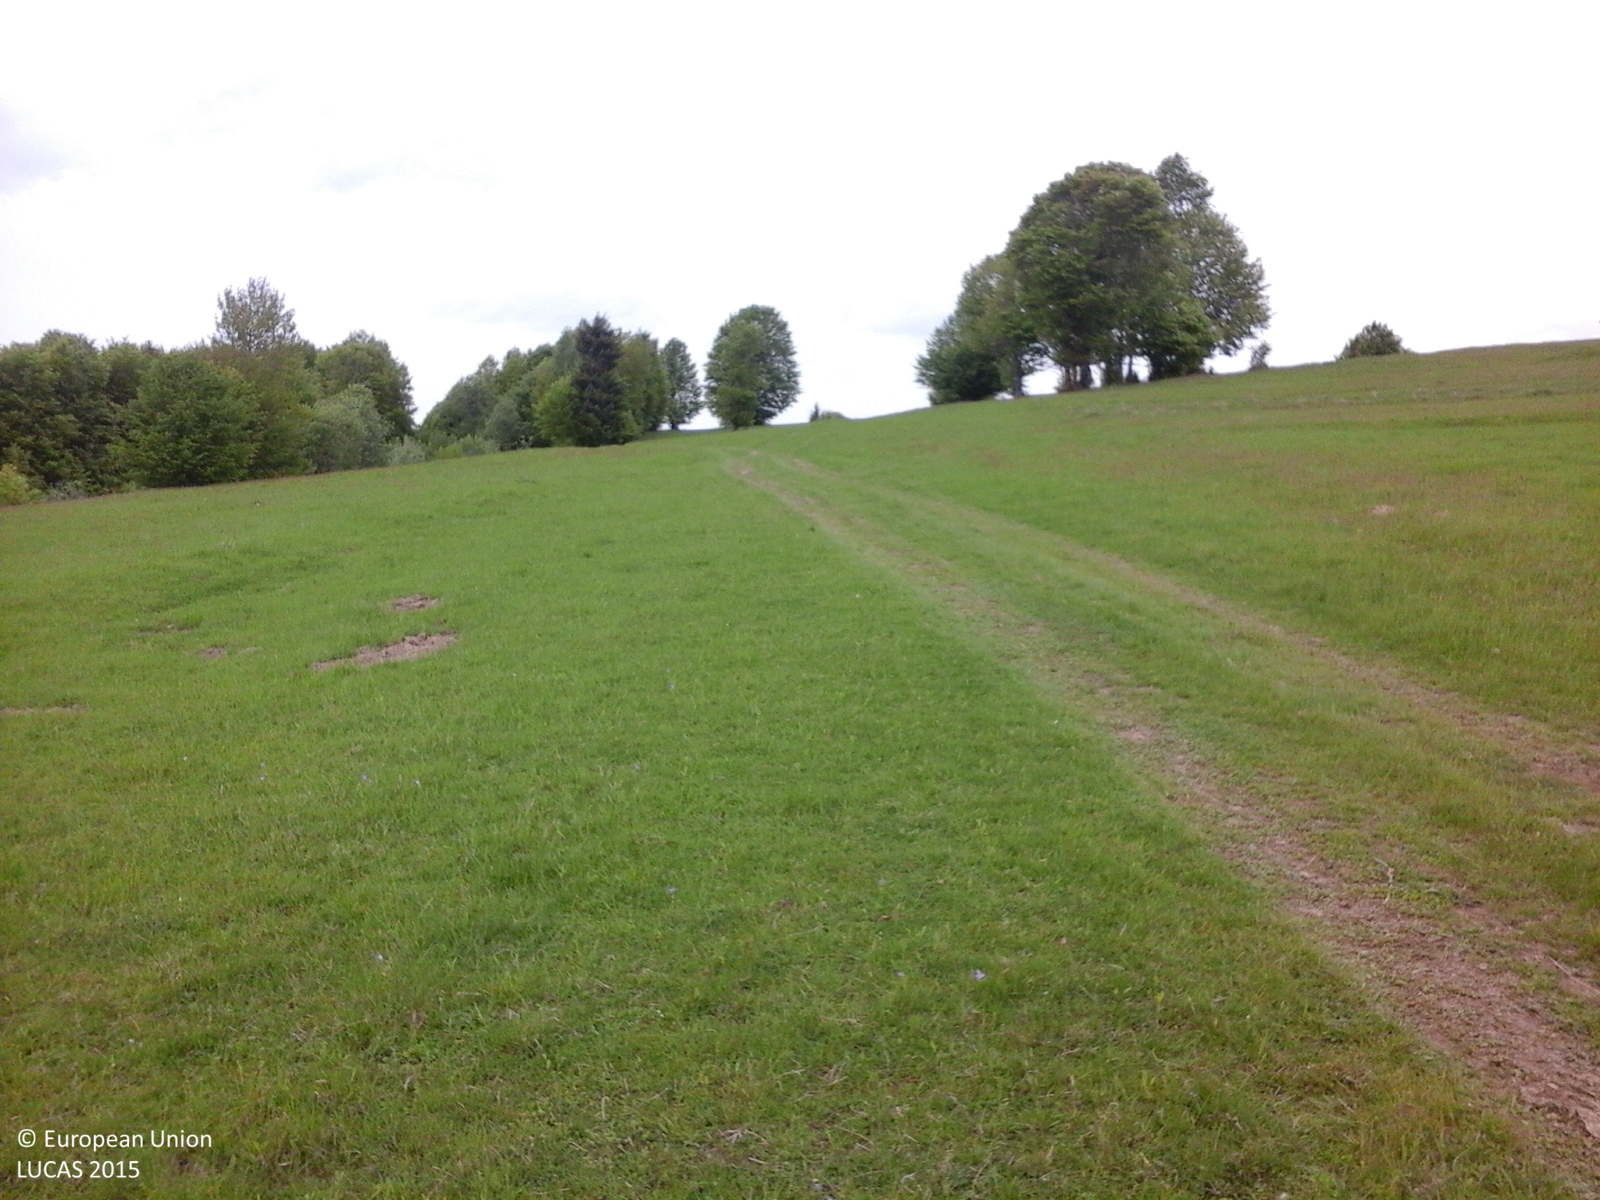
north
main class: Grassland
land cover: Grassland without tree/shrub cover
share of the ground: > 75 %
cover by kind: herbaceous plants 100 %
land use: Agriculture (excluding fallow land and kitchen gardens)
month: May
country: RO
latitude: 45.6448
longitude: 26.0377
